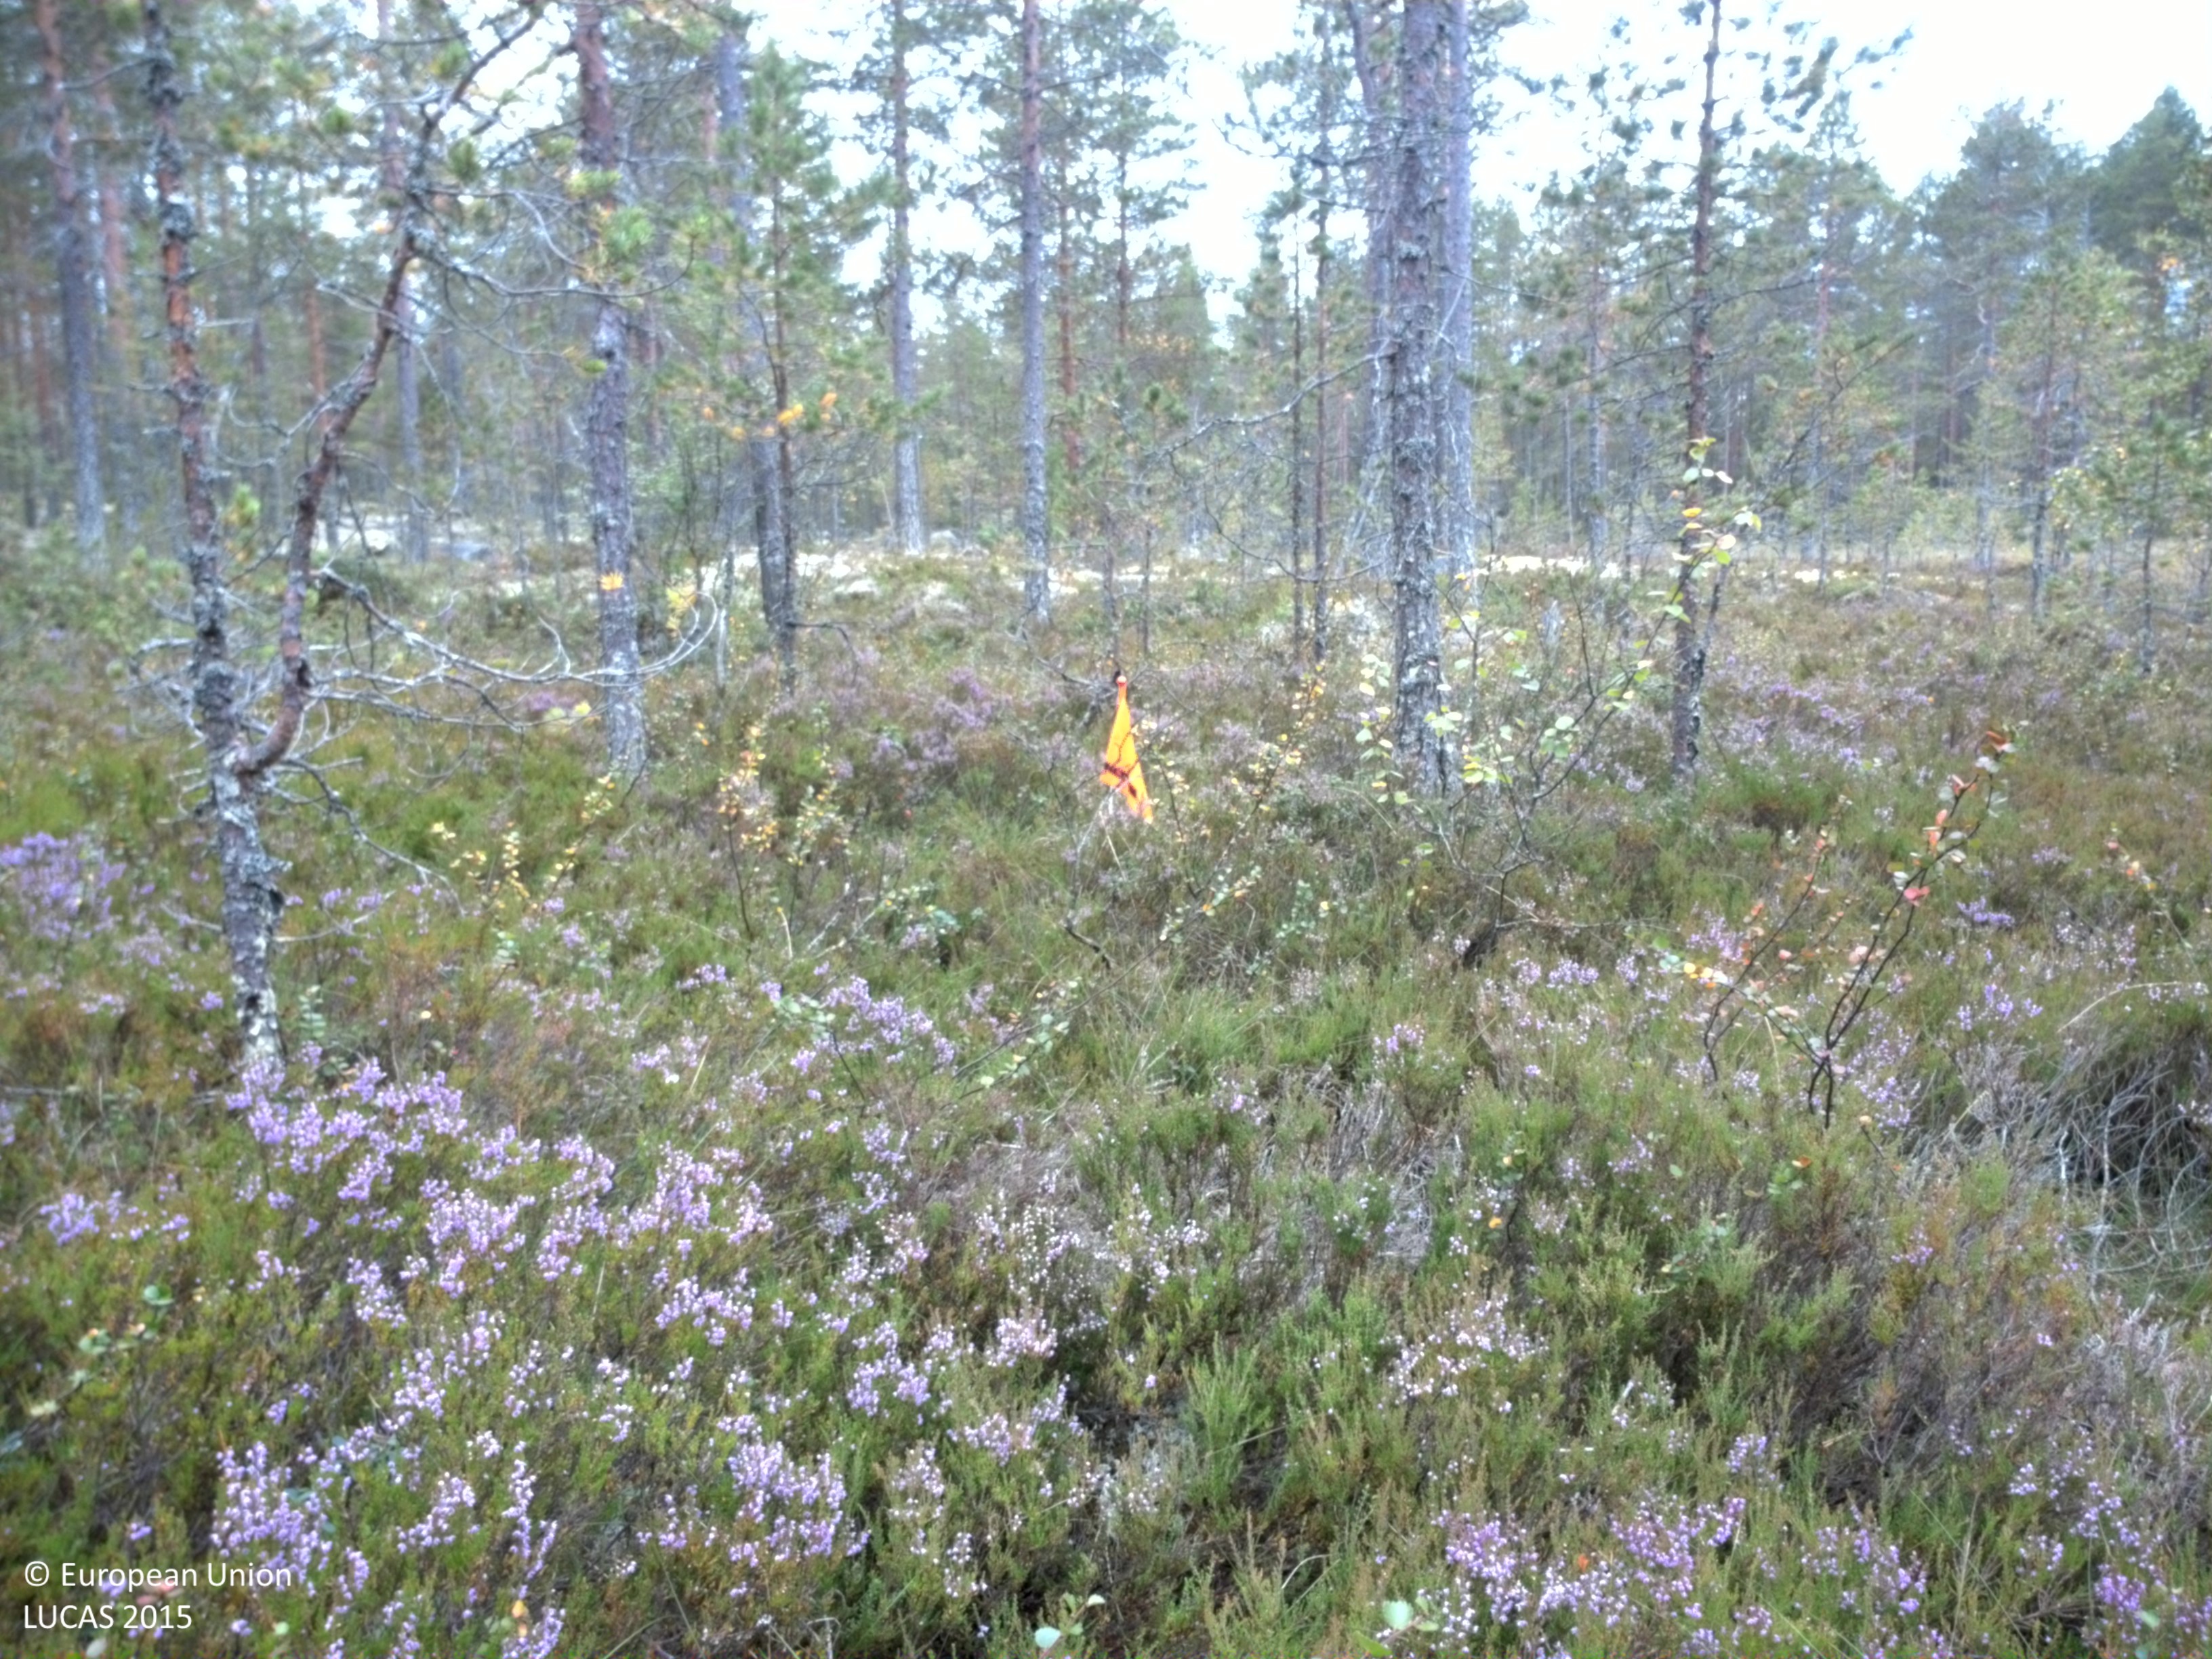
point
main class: Woodland
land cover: Pine dominated coniferous woodland
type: boreal forest
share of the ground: 25 - 50 %
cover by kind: coniferous forest trees 40 %, shrubs 40 %, lichens and mosses 15 %, broadleaved forest trees 5 %
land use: Forestry
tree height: > 5 m
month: August
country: SE
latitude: 61.6961
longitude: 15.0692
